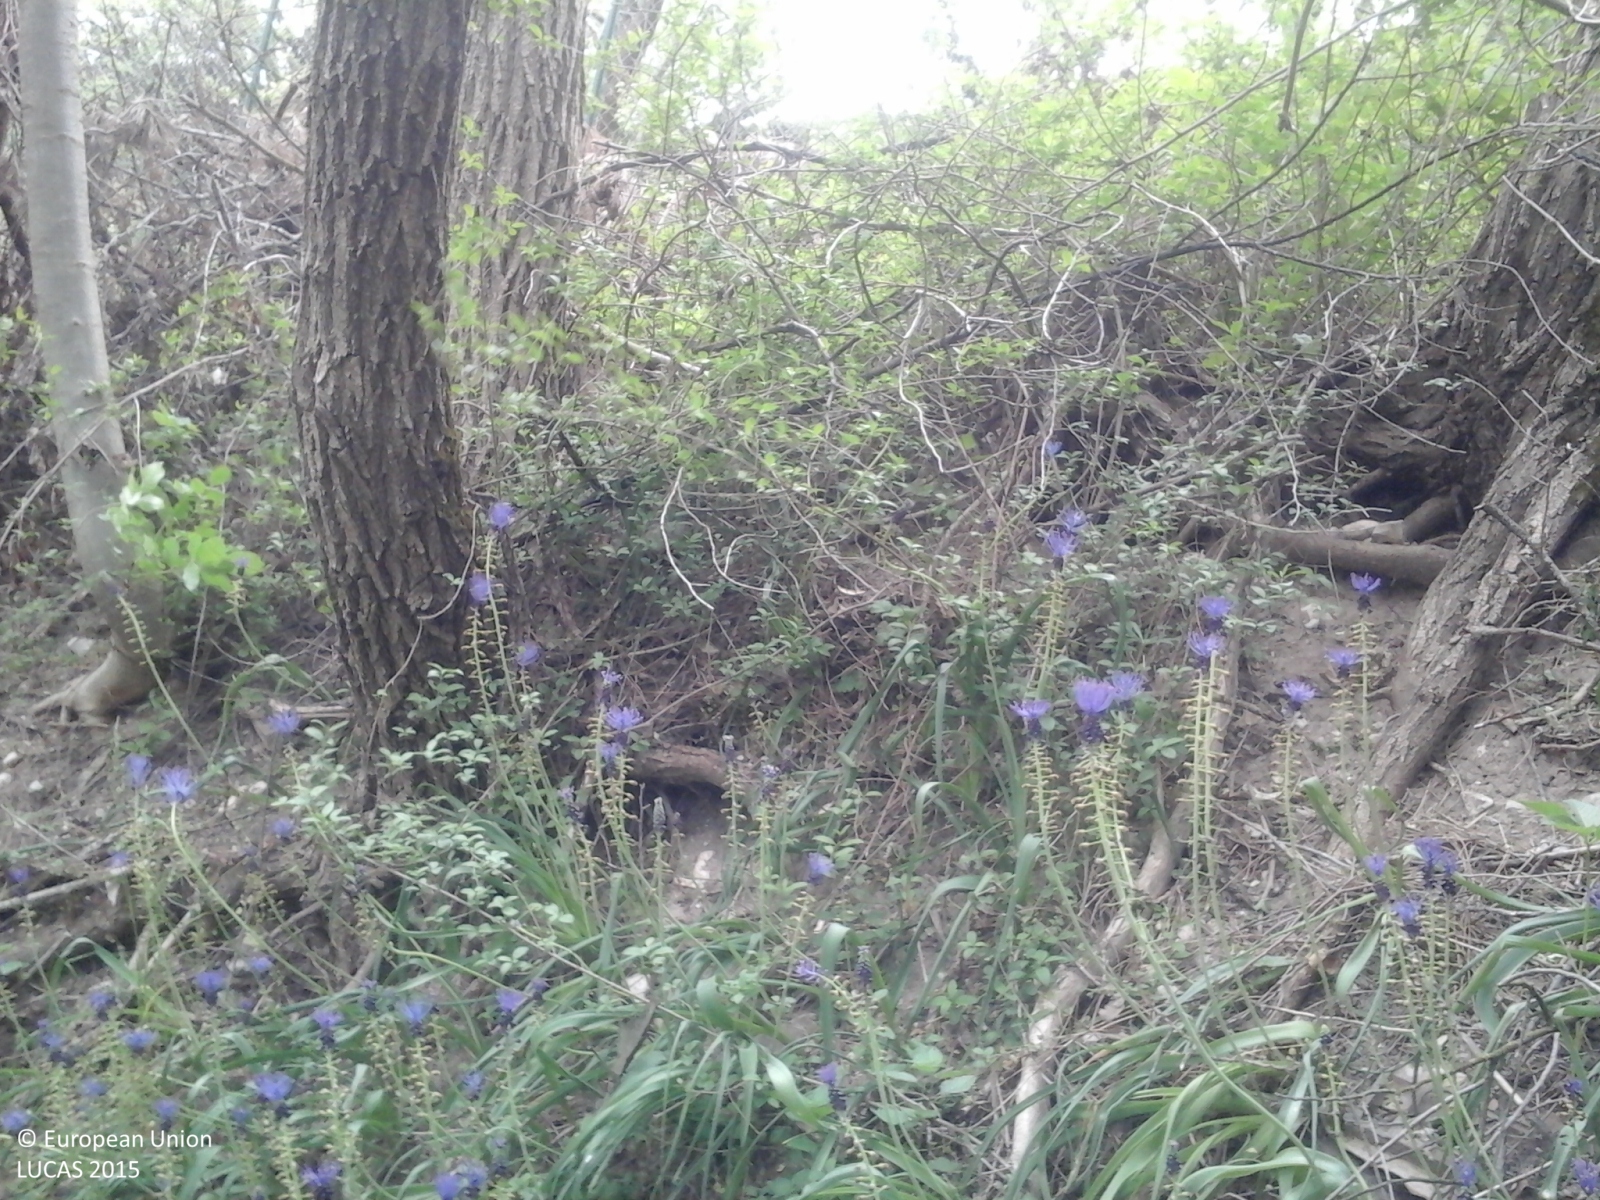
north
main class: Woodland
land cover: Broadleaved woodland
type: thermophilous deciduous forest
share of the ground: > 75 %
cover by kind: broadleaved forest trees 100 %
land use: Forestry
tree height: > 5 m
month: April
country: IT
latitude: 46.2737
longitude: 11.0756
